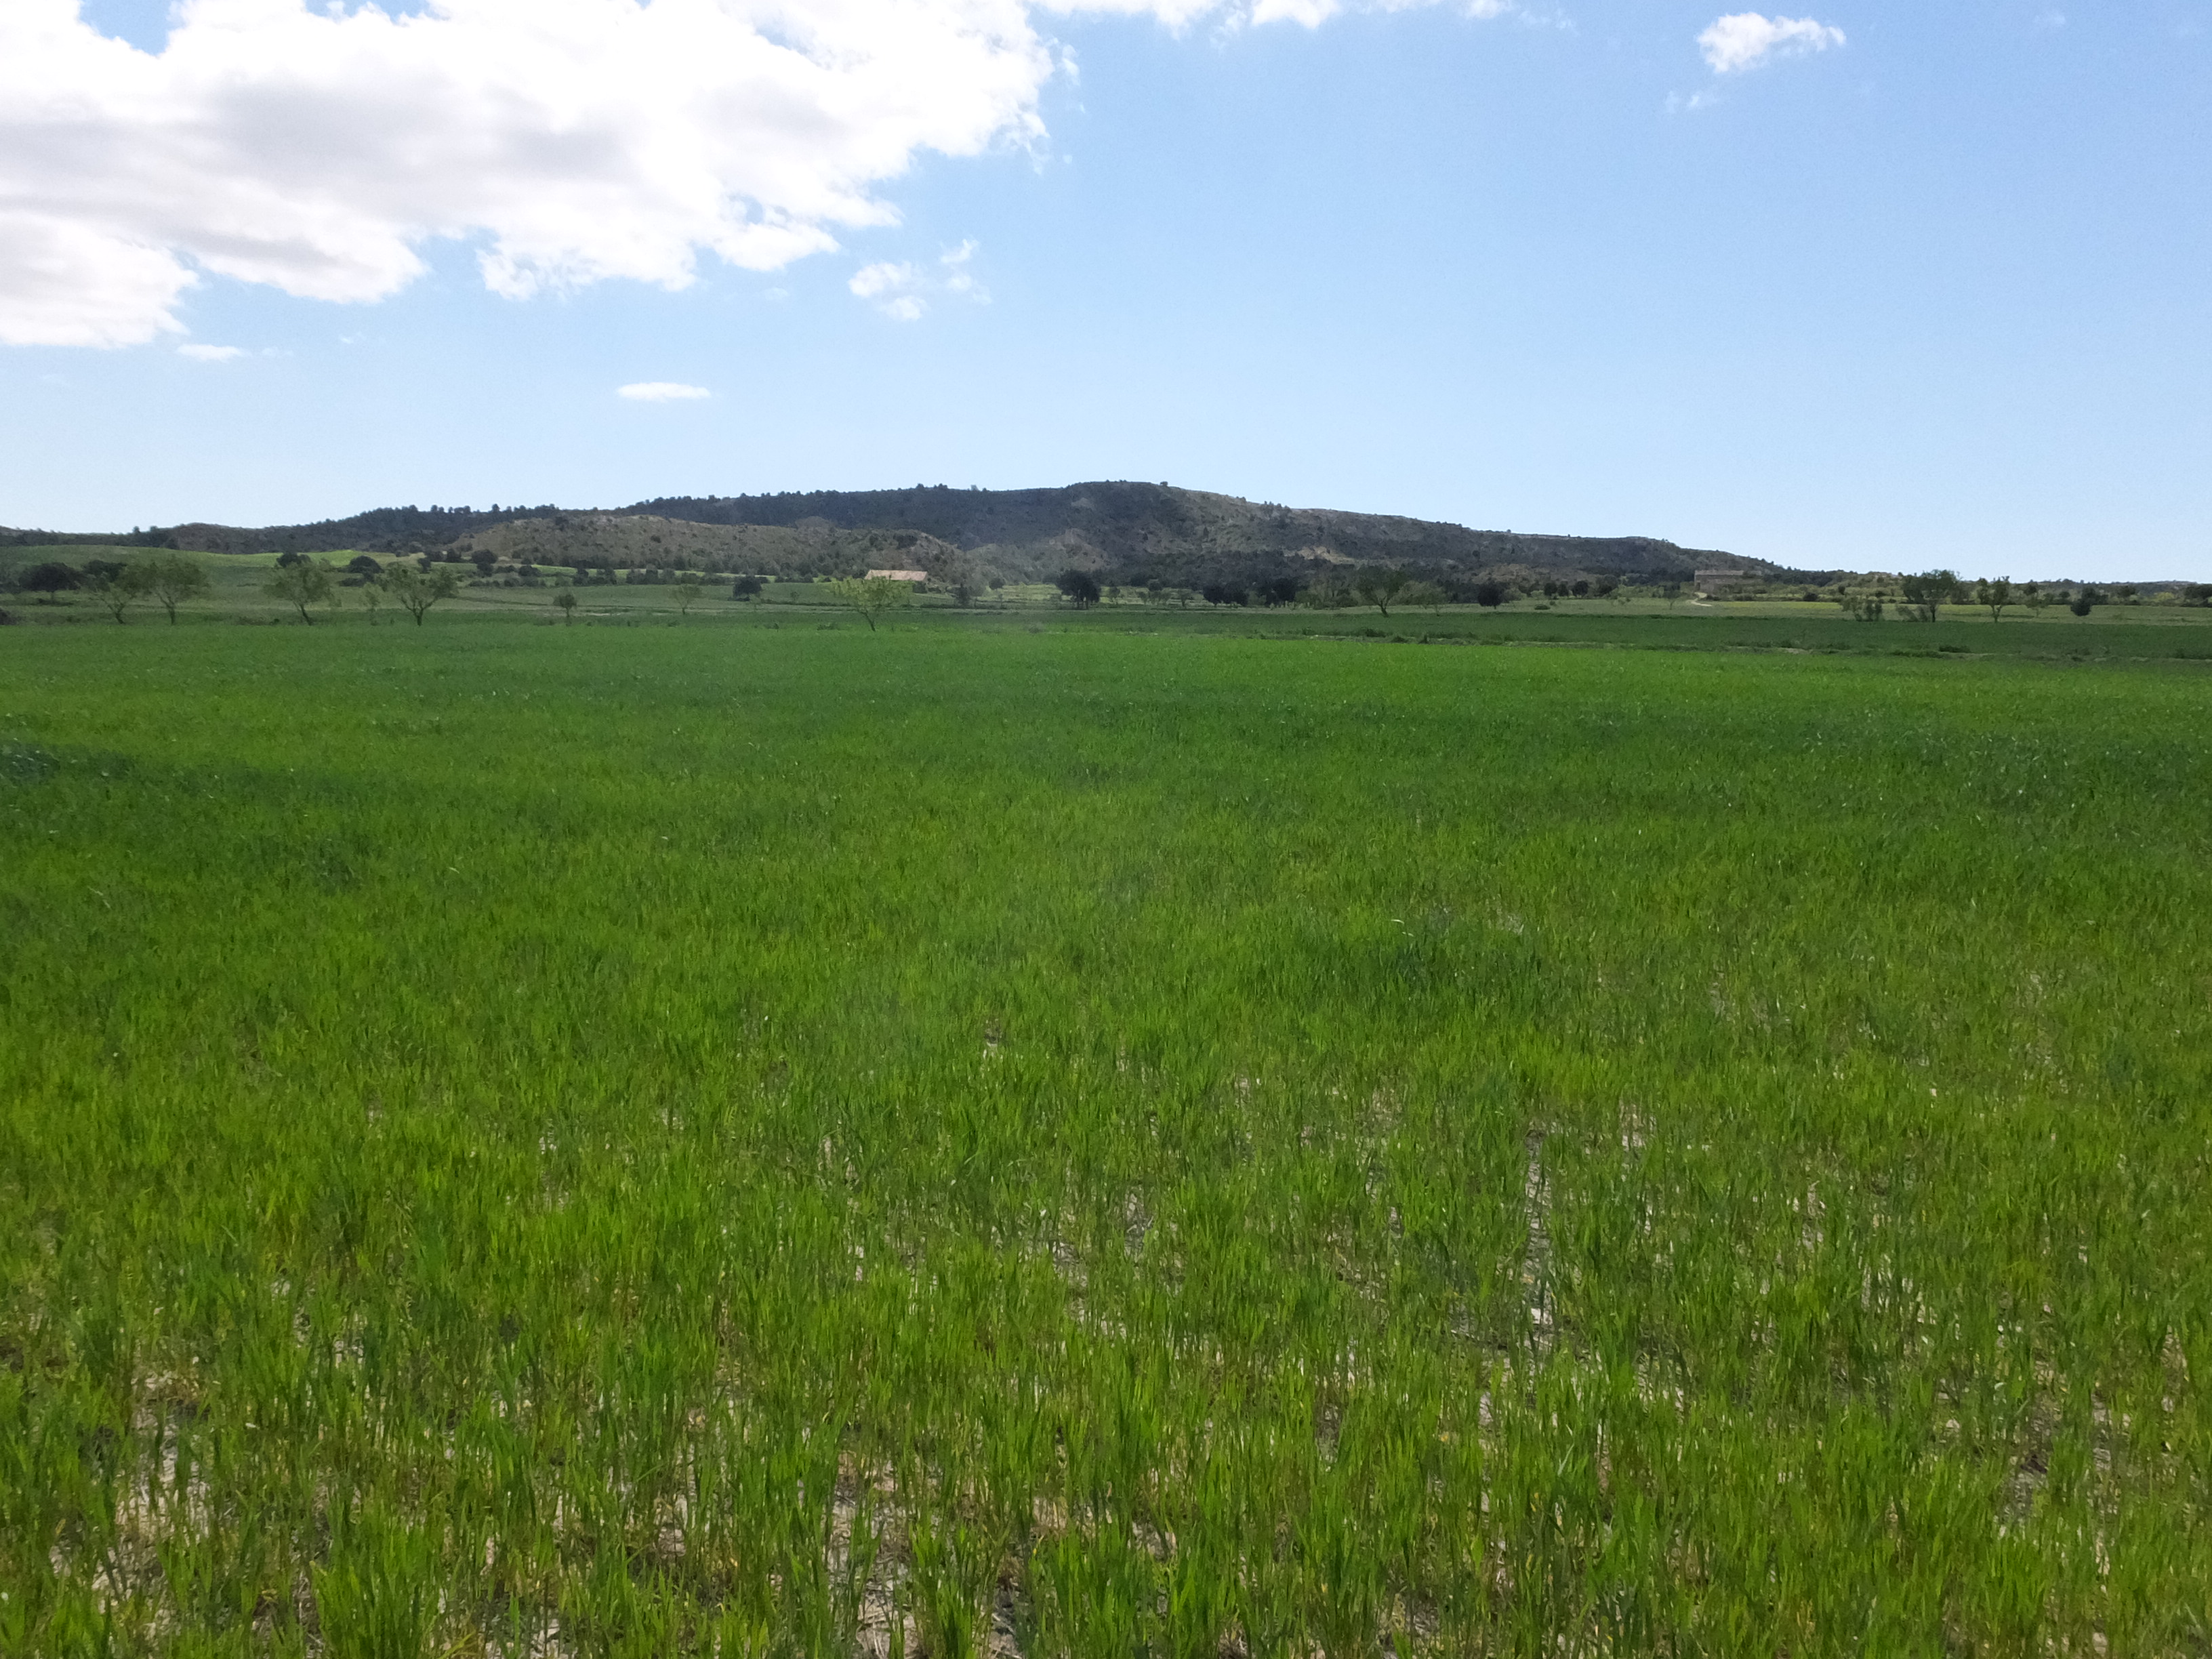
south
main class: Cropland
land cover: Barley
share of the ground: > 75 %
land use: Agriculture (excluding fallow land and kitchen gardens)
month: April
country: ES
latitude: 41.7072
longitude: -0.3176
